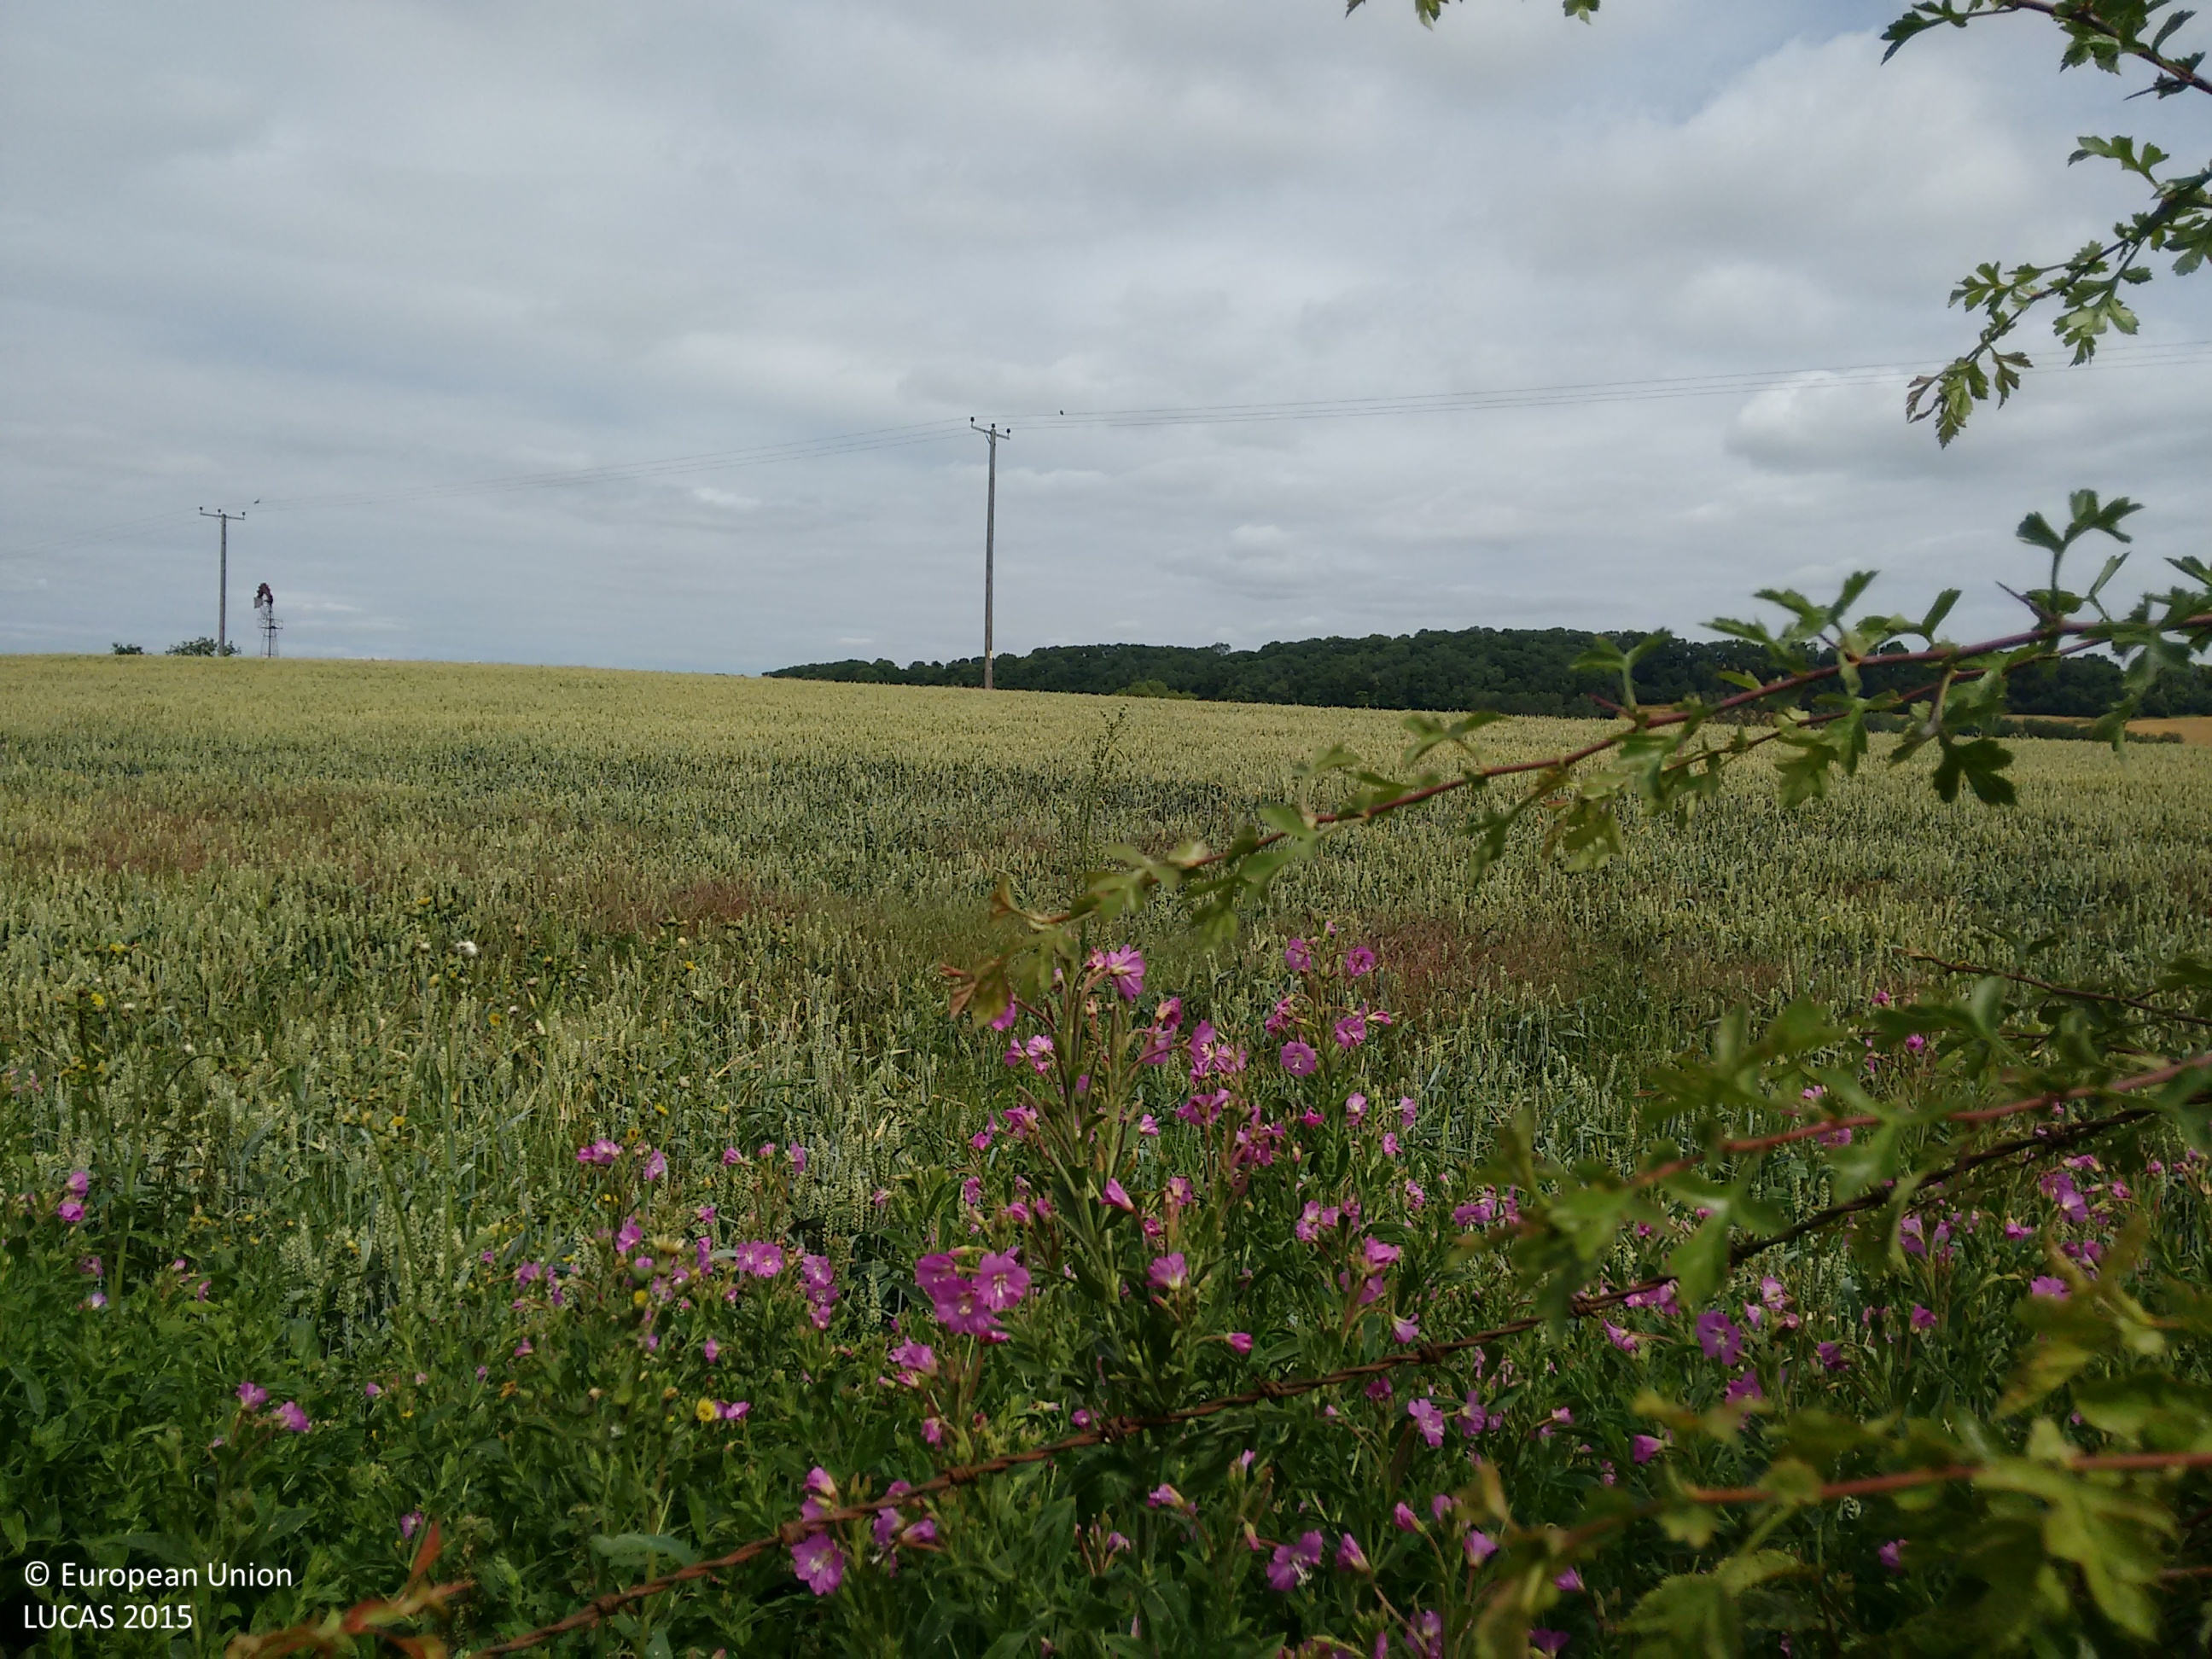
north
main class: Cropland
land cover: Common wheat
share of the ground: > 75 %
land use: Agriculture (excluding fallow land and kitchen gardens)
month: July
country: GB
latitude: 52.1292
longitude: -2.5275
